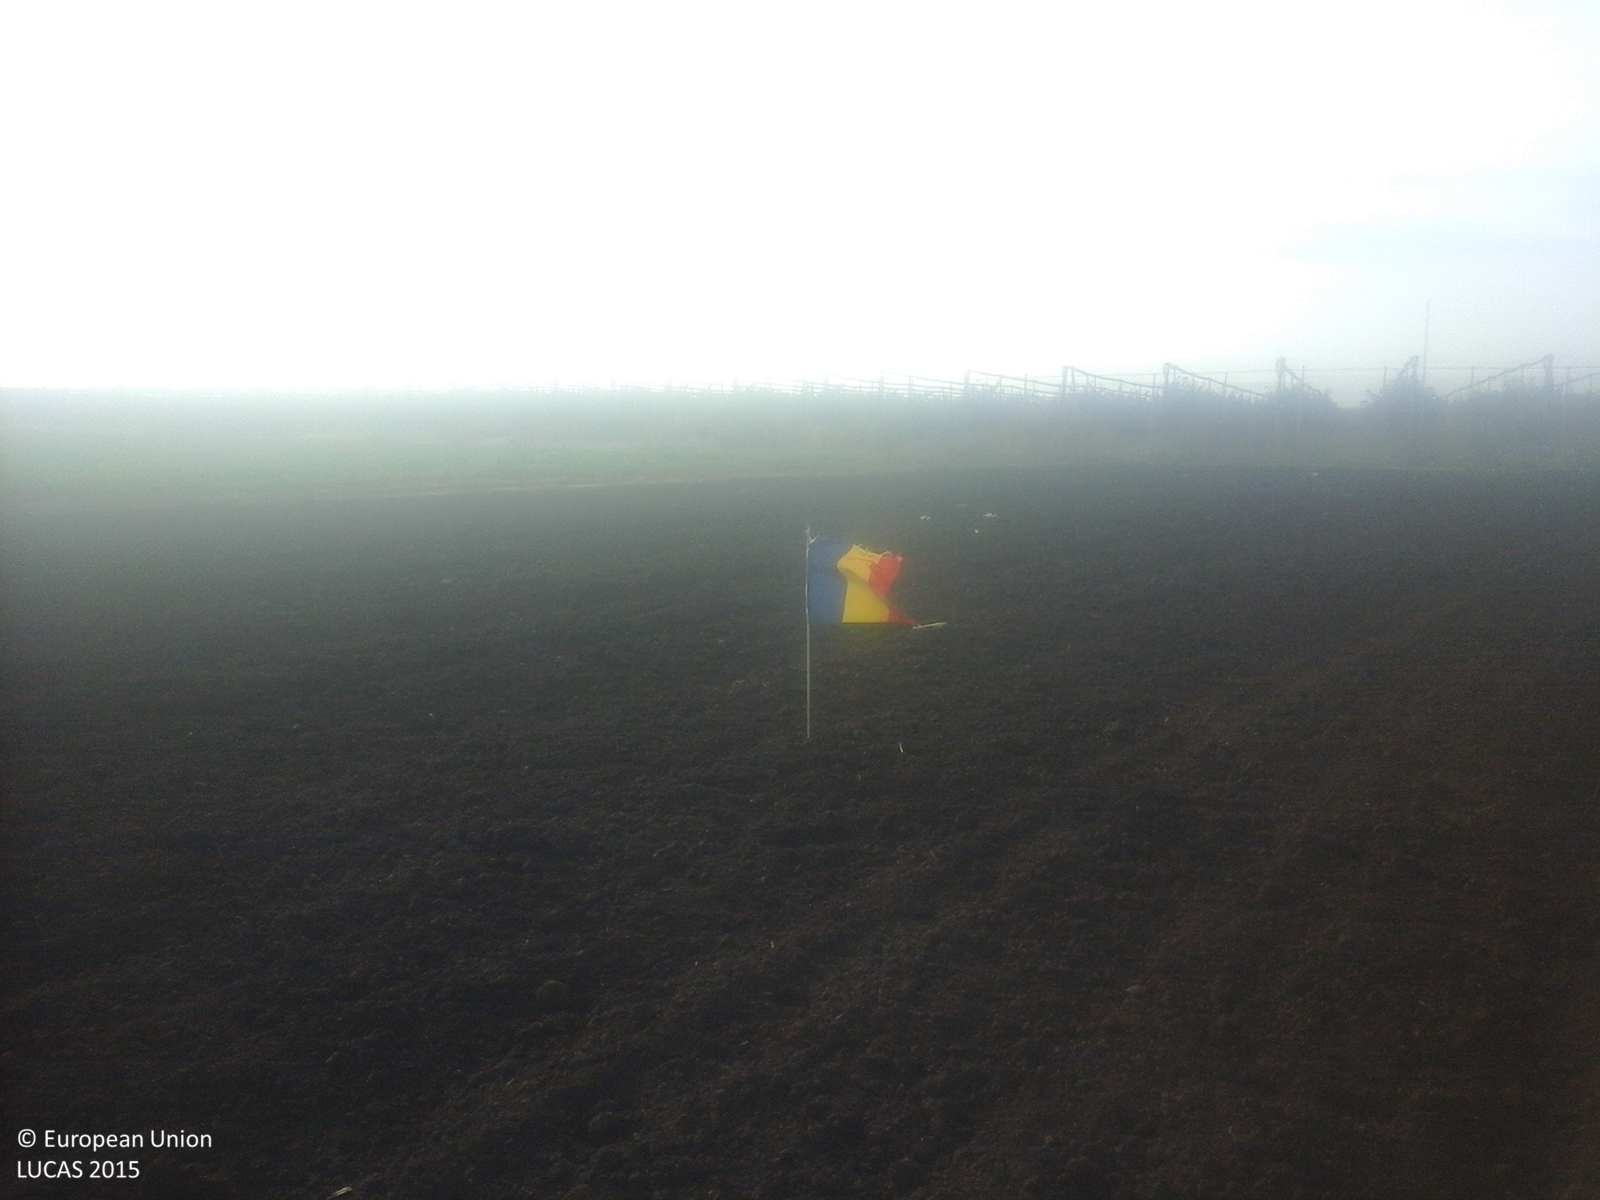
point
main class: Cropland
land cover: Common wheat
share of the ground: < 10 %
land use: Agriculture (excluding fallow land and kitchen gardens)
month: October
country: RO
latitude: 45.4117
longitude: 27.0443
